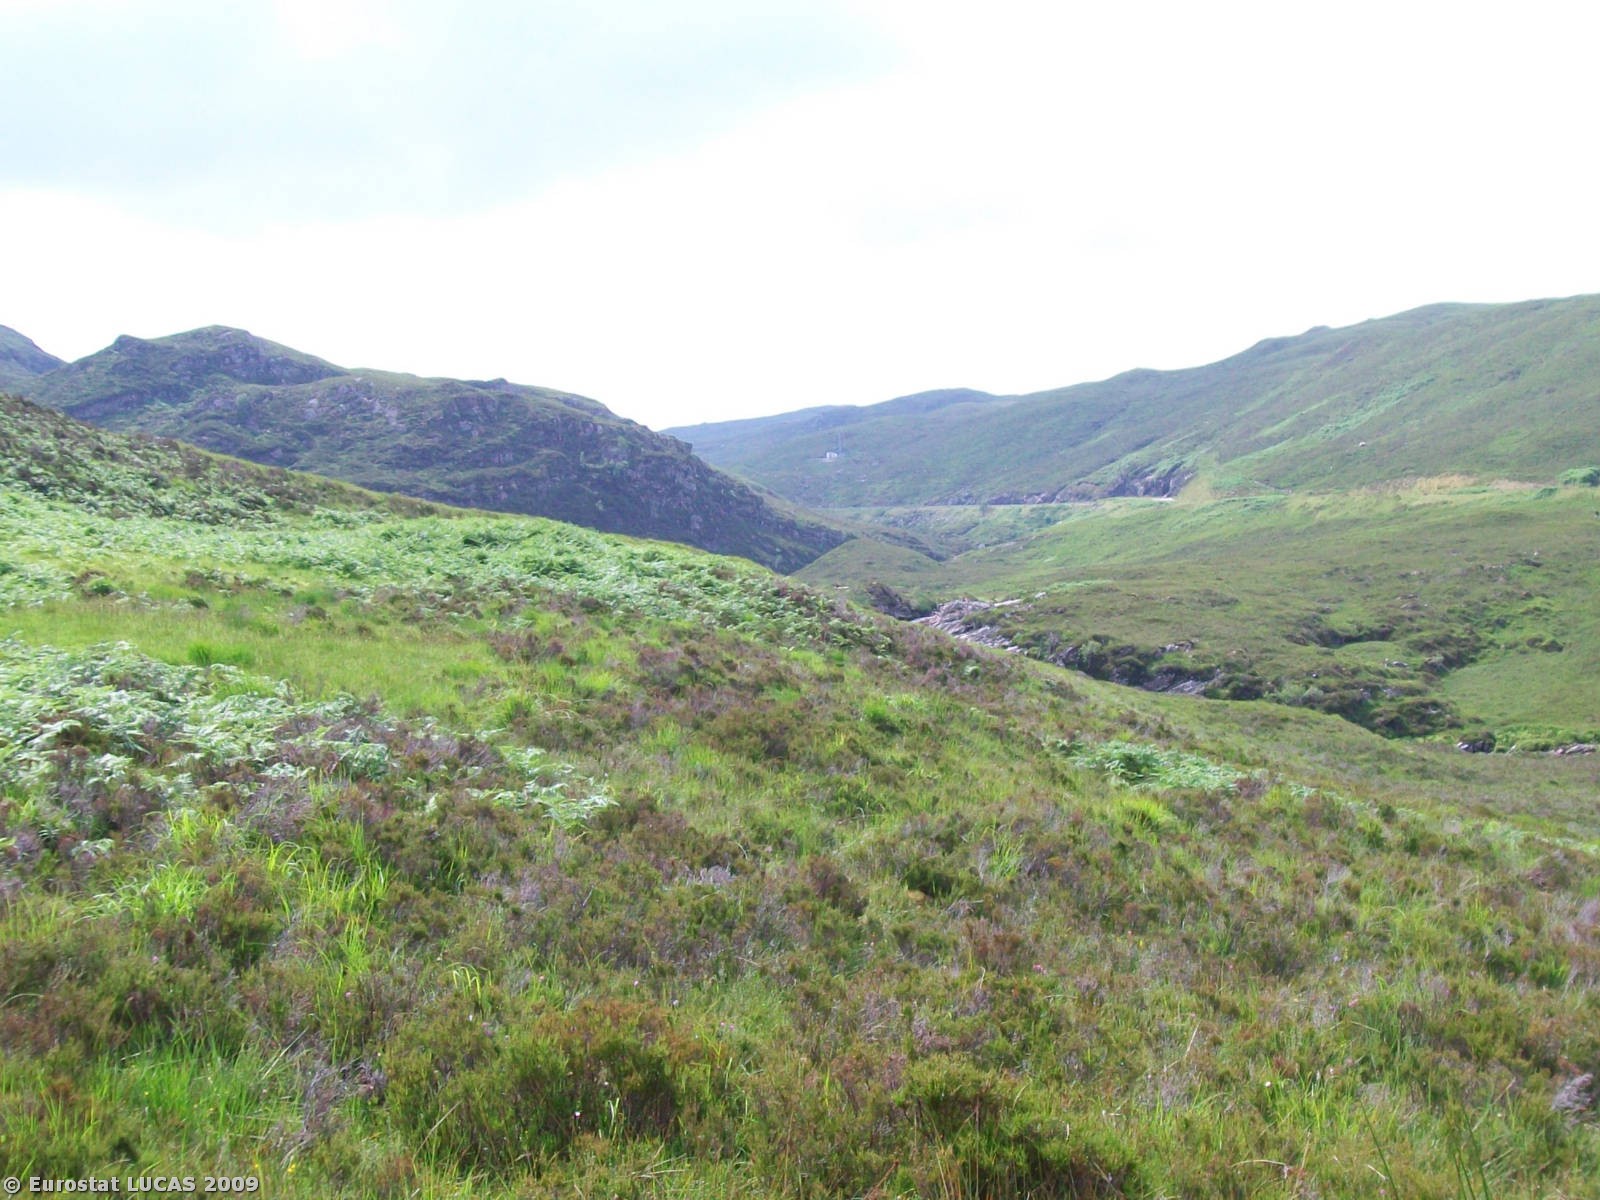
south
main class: Shrubland
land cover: Shrubland without tree cover
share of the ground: > 75 %
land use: Unused
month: July
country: GB
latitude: 57.7925
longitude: -5.1605
